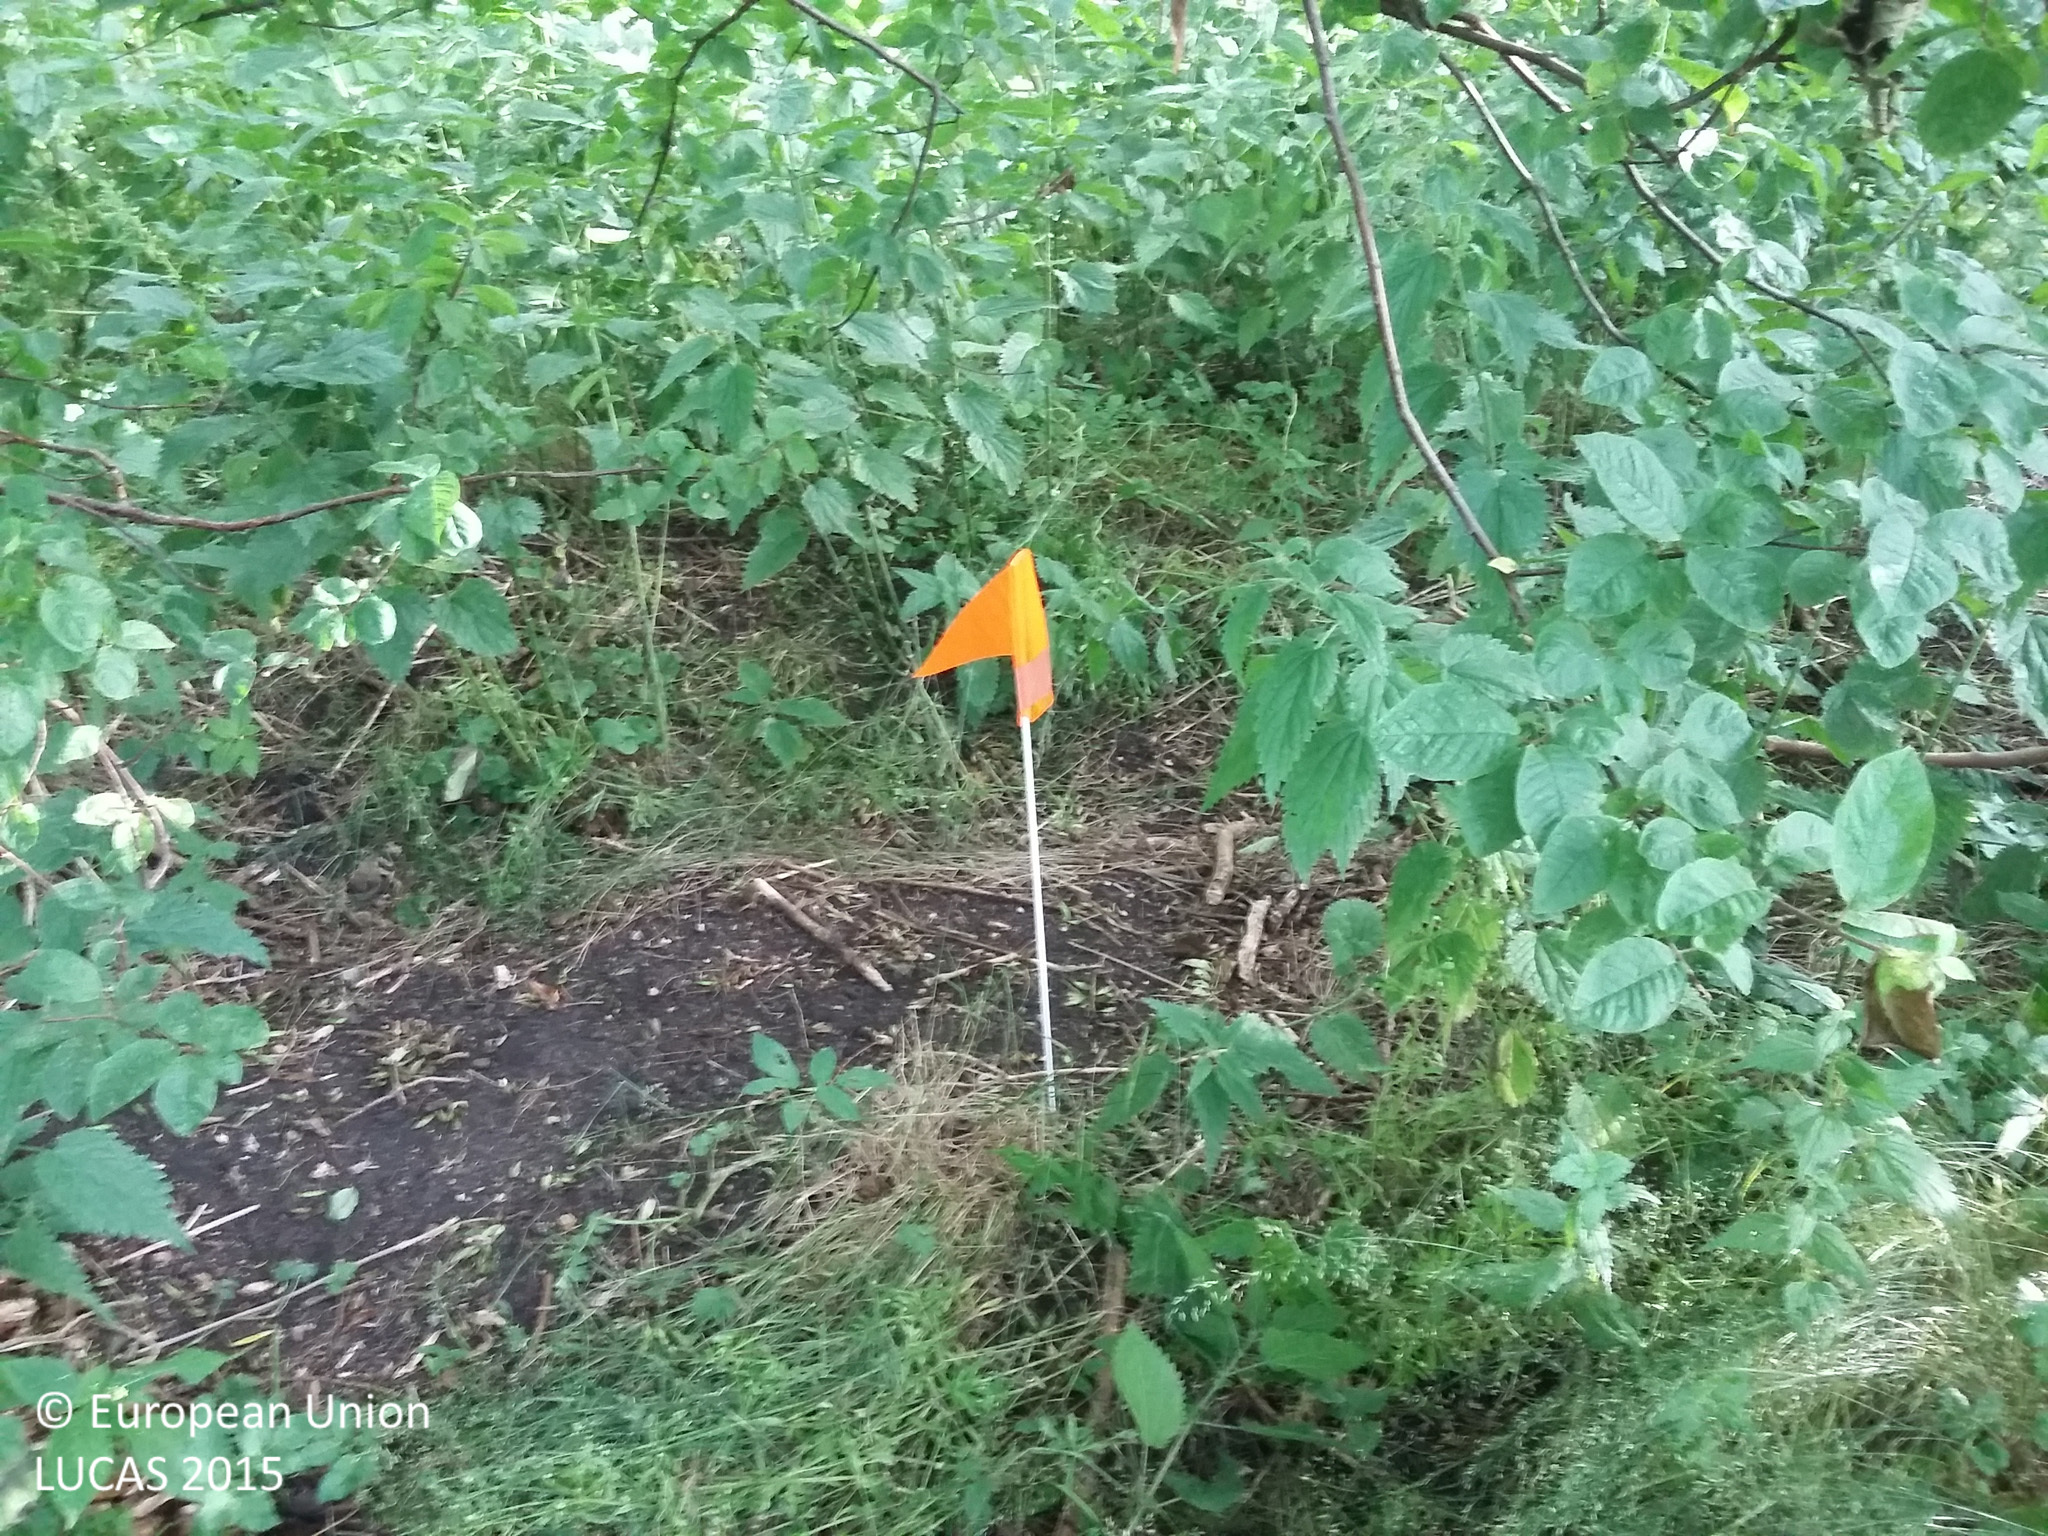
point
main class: Woodland
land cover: Broadleaved woodland
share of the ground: > 75 %
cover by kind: broadleaved forest trees 70 %, herbaceous plants 30 %
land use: Semi-natural and natural areas not in use
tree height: > 5 m
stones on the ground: < 10 %
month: July
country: DK
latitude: 55.8132
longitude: 11.9610
